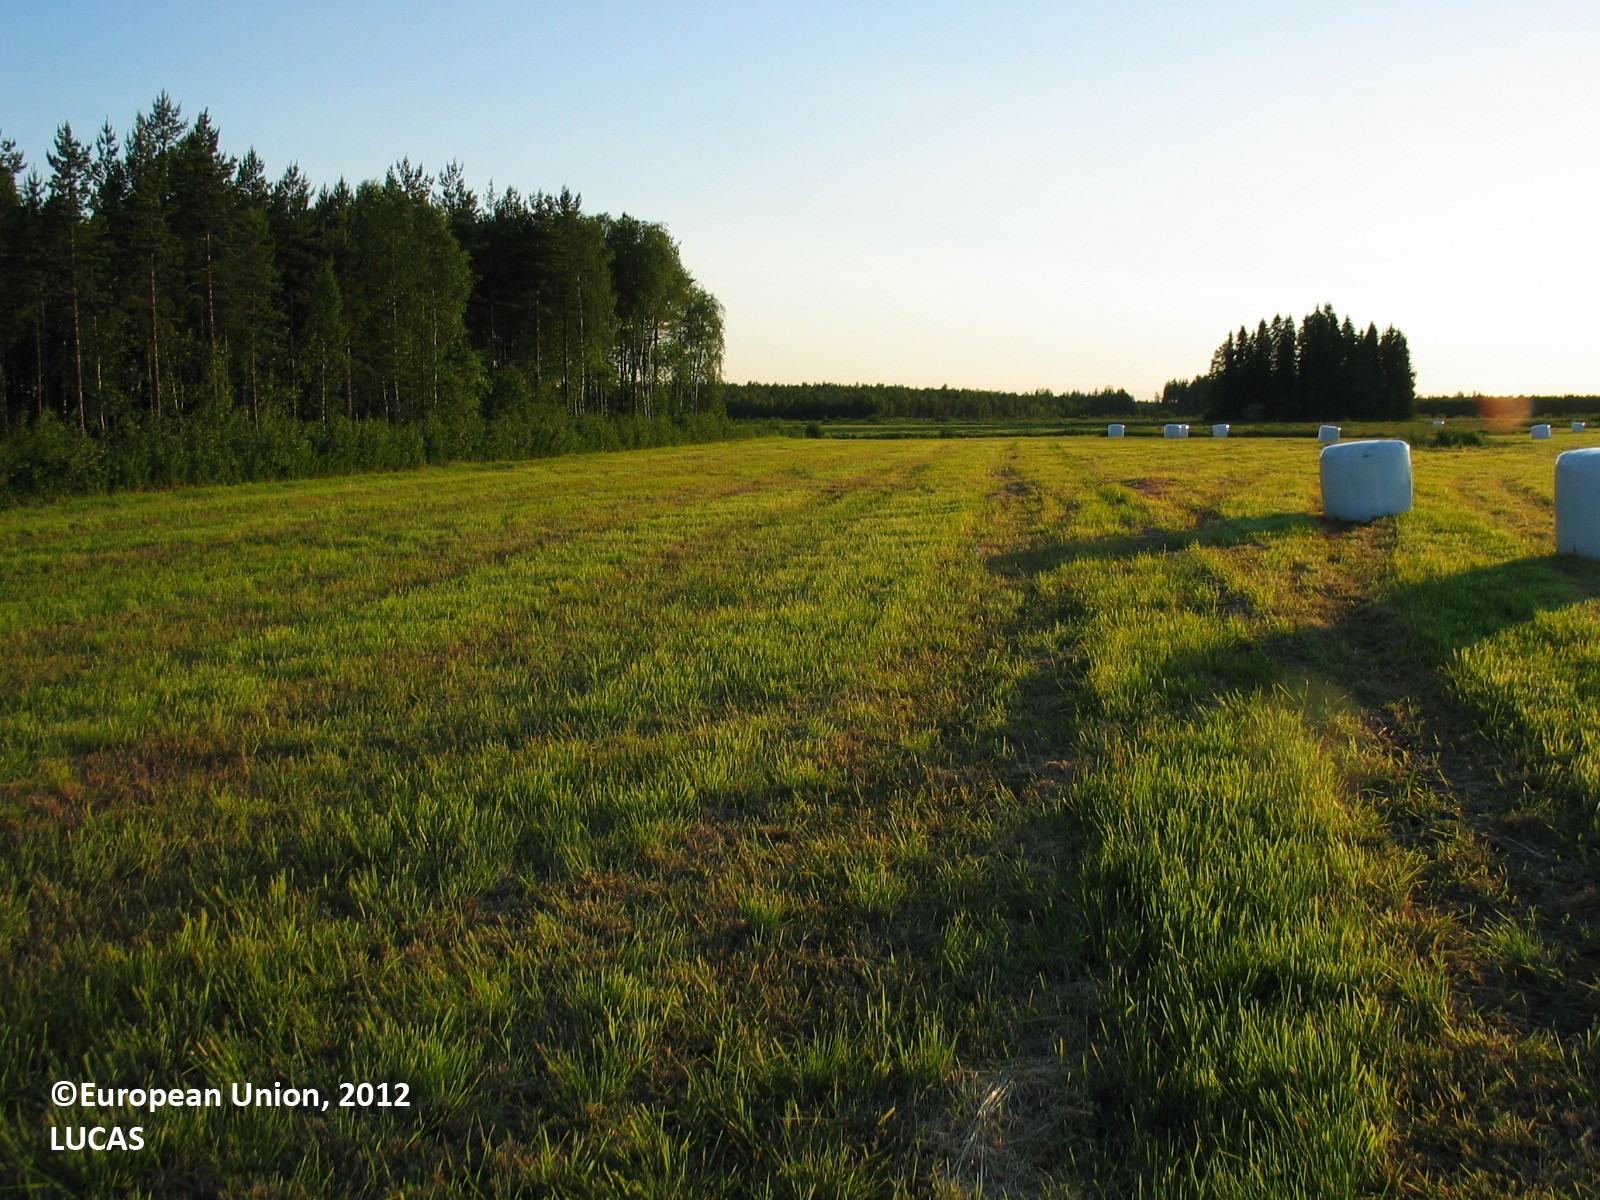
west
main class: Cropland
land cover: Temporary grasslands
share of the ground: > 75 %
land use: Agriculture (excluding fallow land and kitchen gardens)
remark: Harvested field
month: July
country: FI
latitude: 64.4156
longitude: 26.3202
